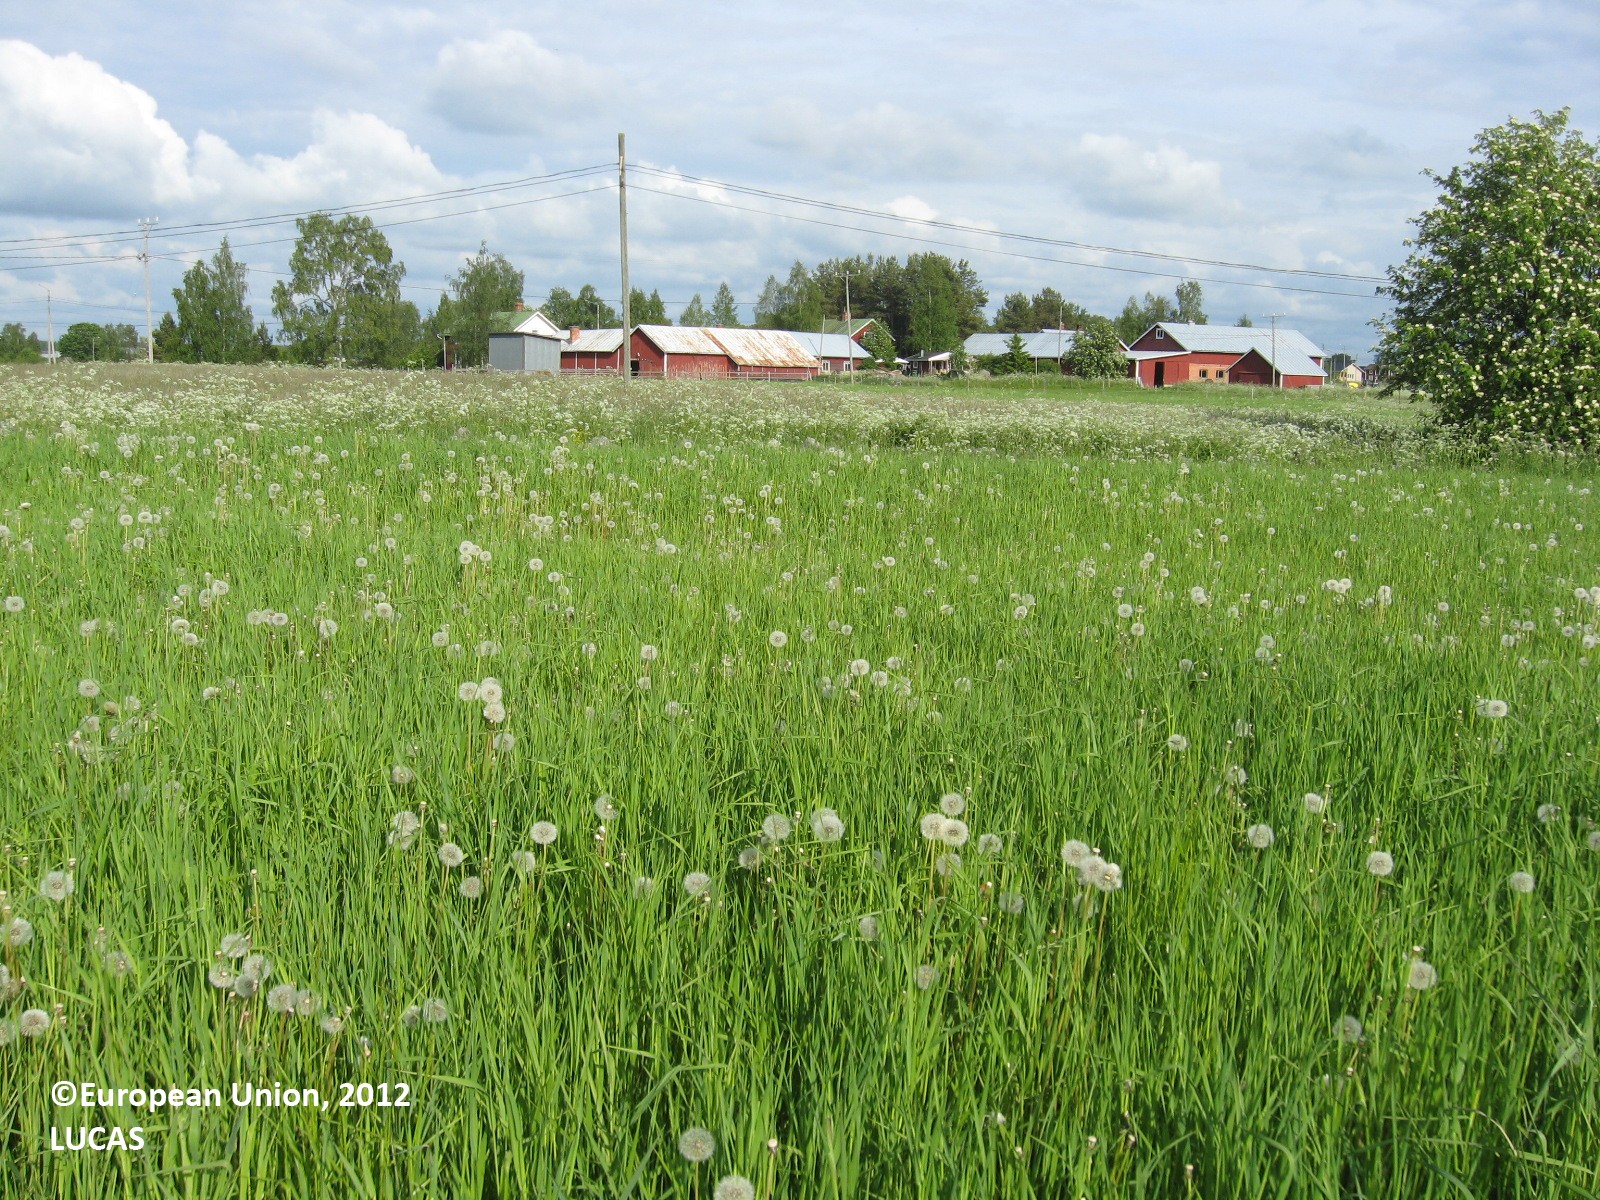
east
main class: Cropland
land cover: Temporary grasslands
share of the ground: > 75 %
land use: Agriculture (excluding fallow land and kitchen gardens)
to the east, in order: Temporary grasslands; Shruby margins; Ditches and canals; Shruby margins; Temporary grasslands; Electric lines; Temporary grasslands; Ditches and canals; Temporary grasslands; Fences; Grassland without tree/shrub cover; Fences; Grassland without tree/shrub cover; Fences; Grassland without tree/shrub cover; Fences; Grassland without tree/shrub cover; Ditches and canals; Grass margins; Paved roads, cycling and walking lanes; Grassland without tree/shrub cover
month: June
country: FI
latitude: 62.9086
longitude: 21.6345
